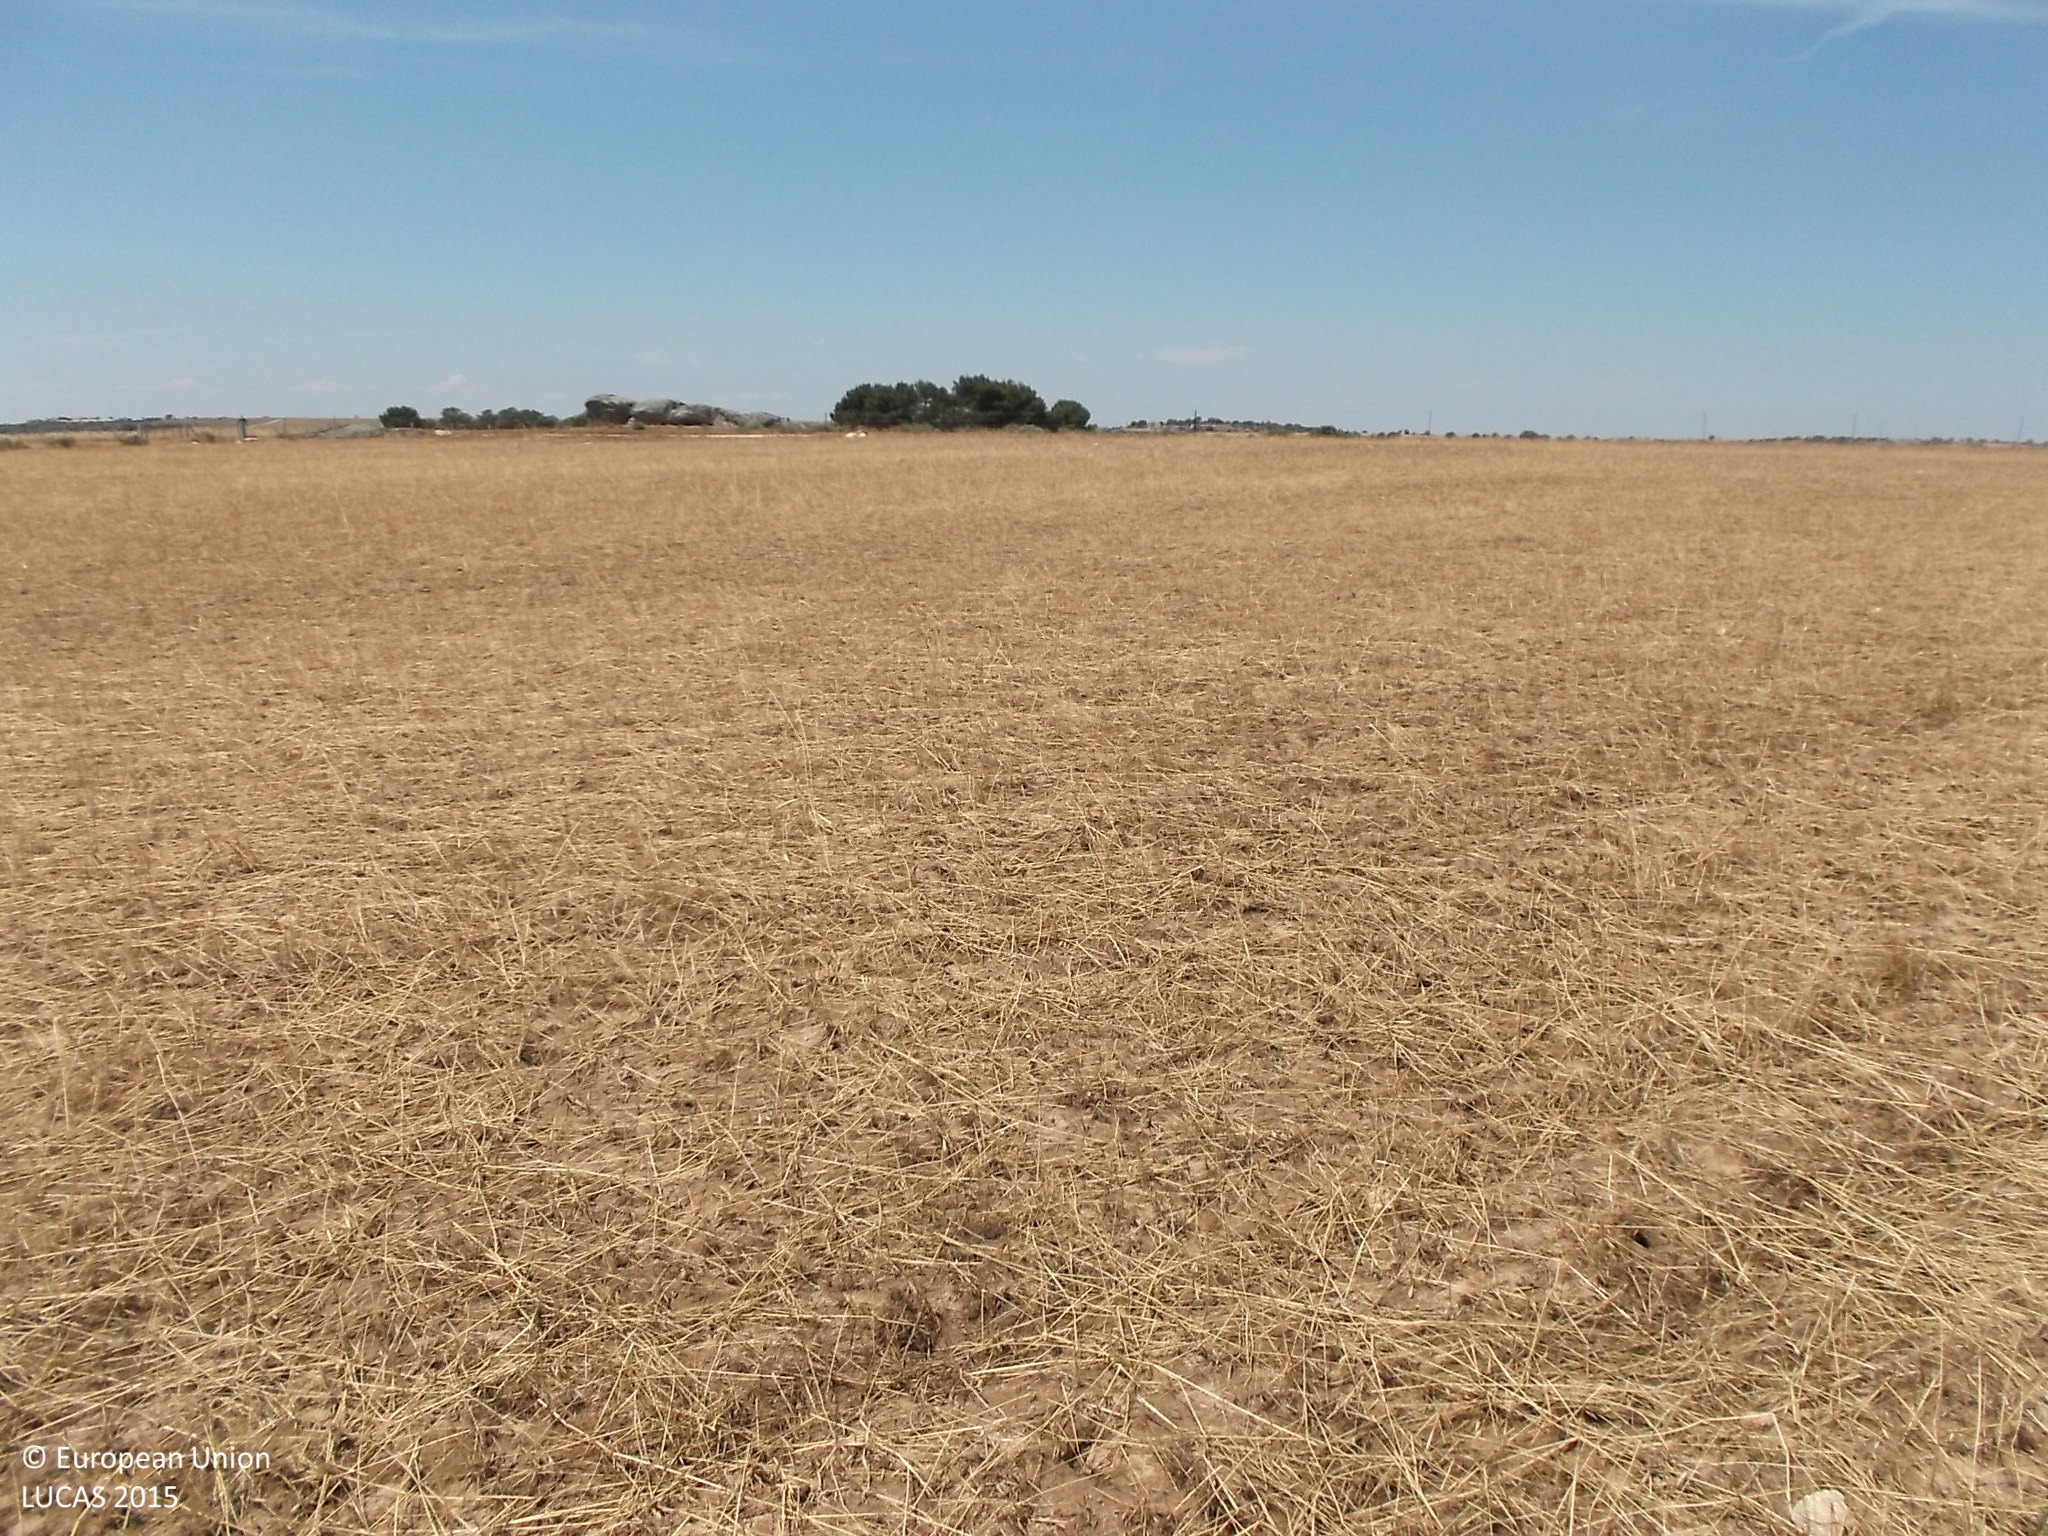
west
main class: Cropland
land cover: Rye
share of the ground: < 10 %
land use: Agriculture (excluding fallow land and kitchen gardens)
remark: Harvested field
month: June
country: ES
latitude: 41.2547
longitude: -6.0457
